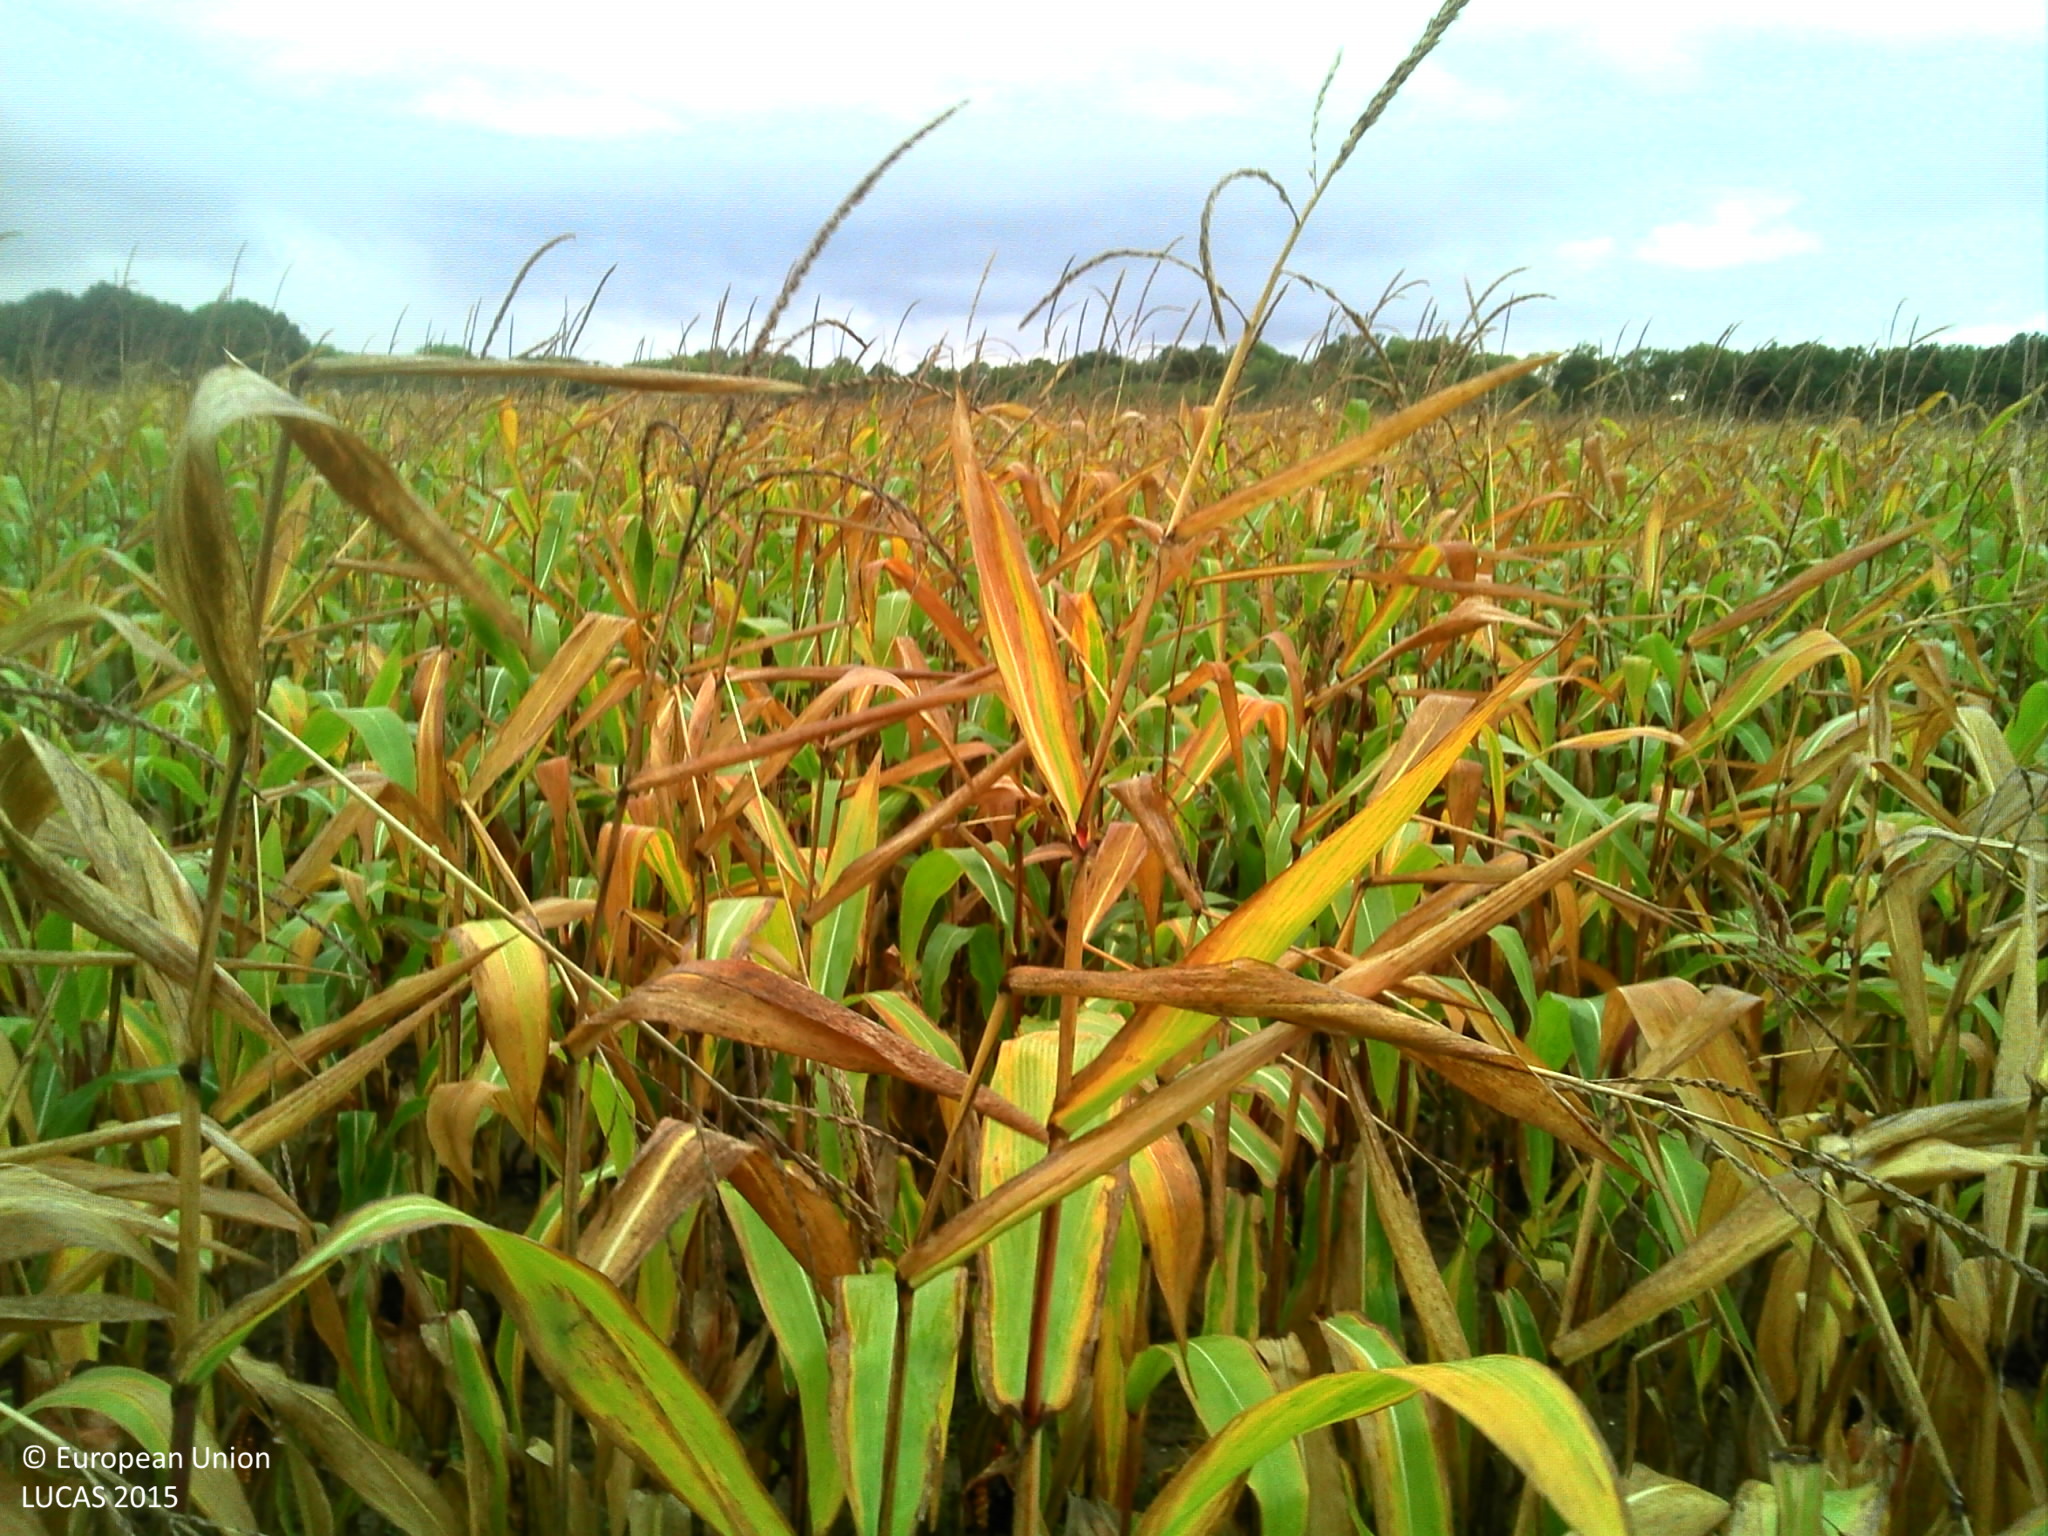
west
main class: Cropland
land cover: Maize
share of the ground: > 75 %
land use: Agriculture (excluding fallow land and kitchen gardens)
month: October
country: FR
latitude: 48.2329
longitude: 4.1942
